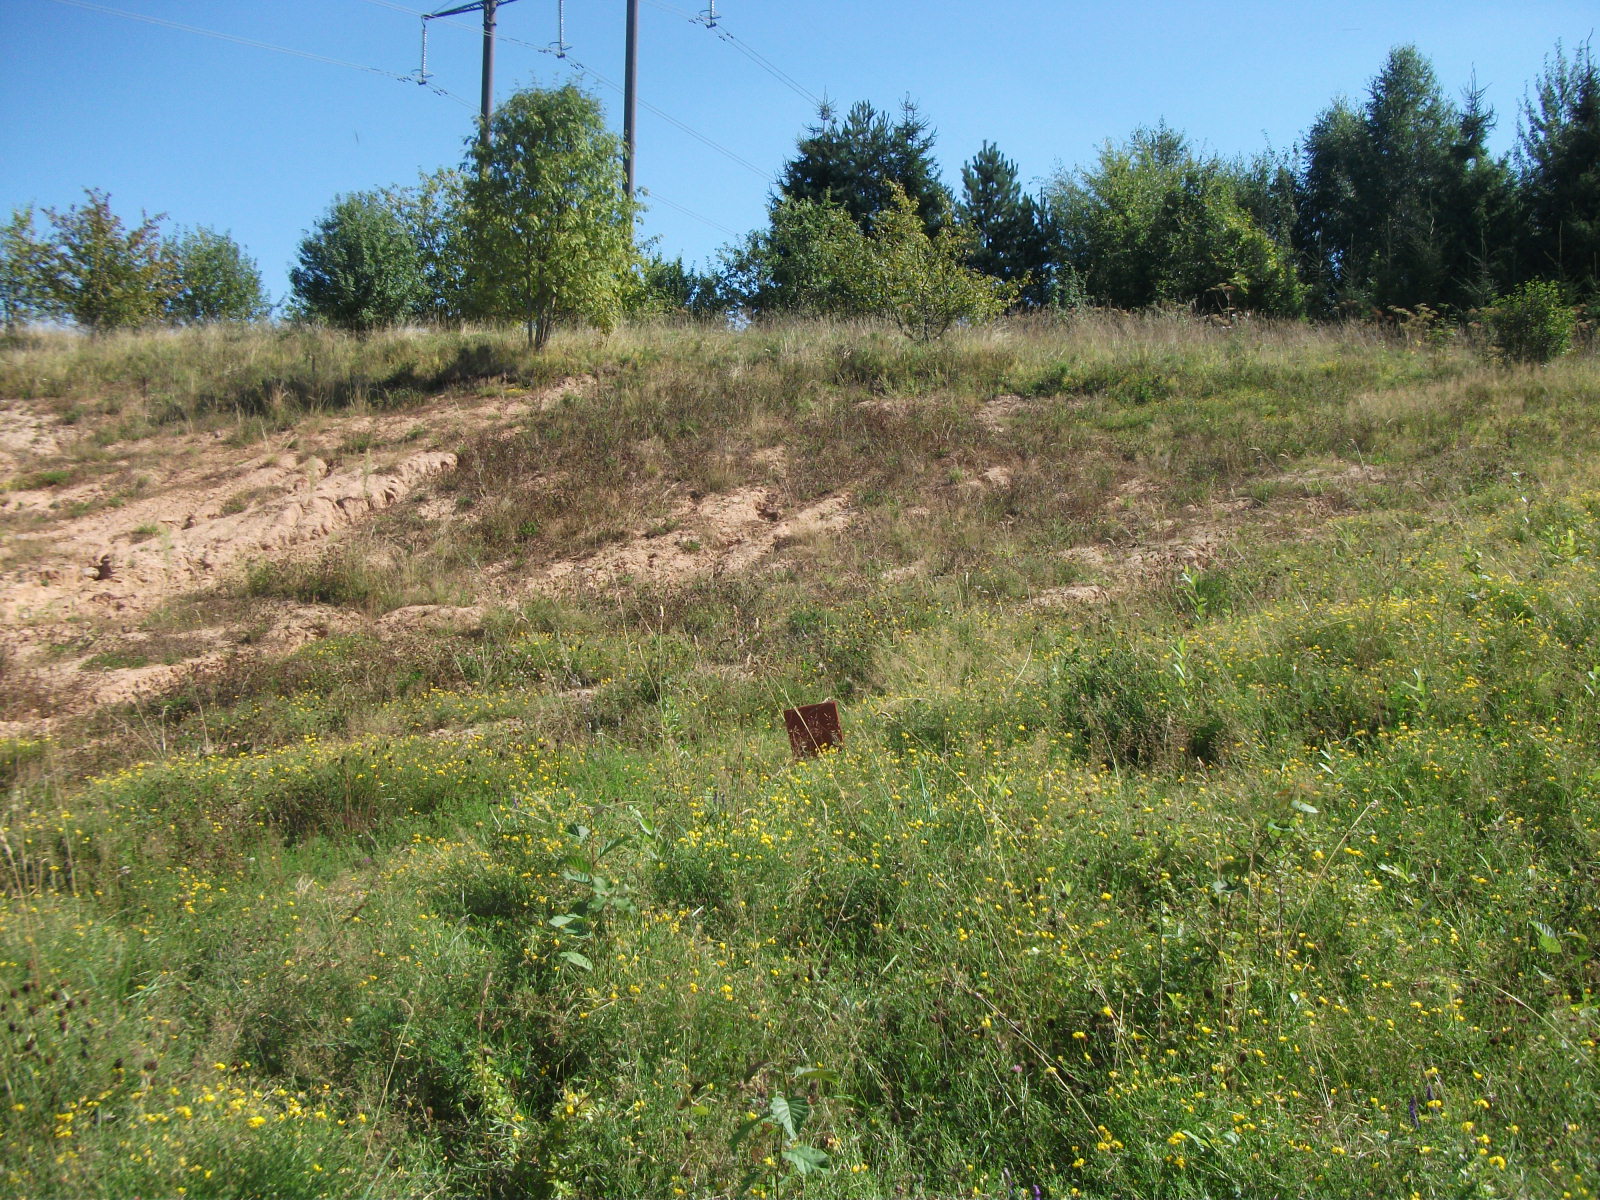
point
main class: Grassland
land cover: Spontaneously vegetated surfaces
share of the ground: > 75 %
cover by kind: herbaceous plants 85 %, unconsolidated bare surface 10 %, shrubs 5 %
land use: Abandoned areas
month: August
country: LV
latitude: 56.4753
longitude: 26.0283
